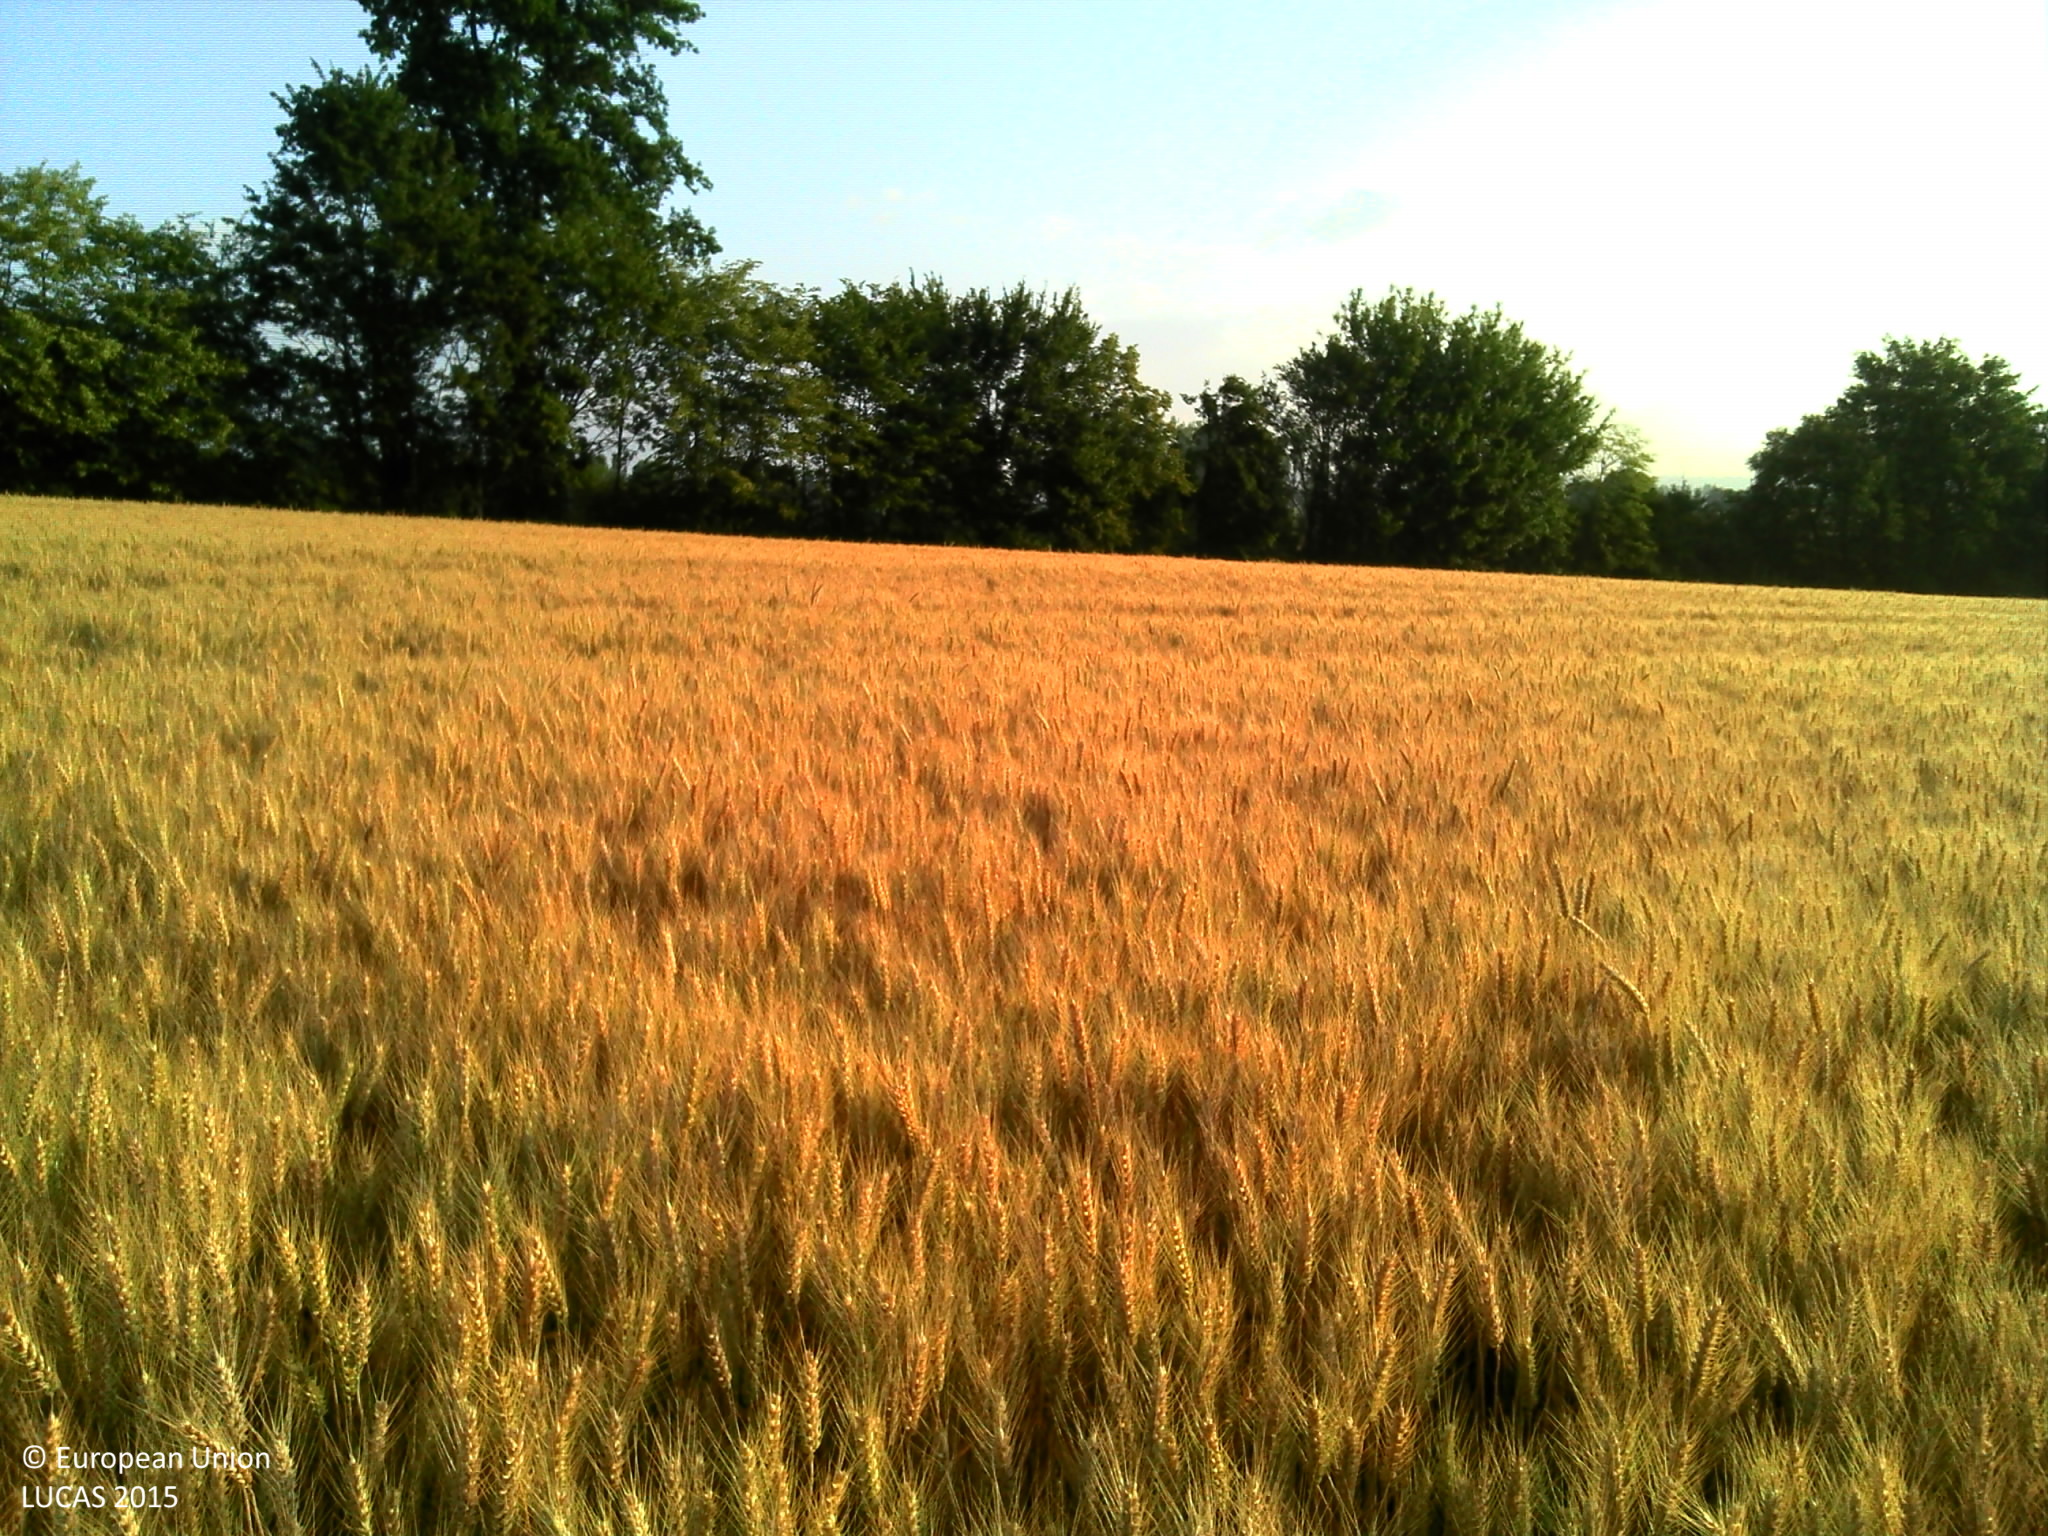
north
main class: Cropland
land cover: Common wheat
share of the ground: > 75 %
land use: Agriculture (excluding fallow land and kitchen gardens)
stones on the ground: < 10 %
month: July
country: FR
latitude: 49.0745
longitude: 0.0172
